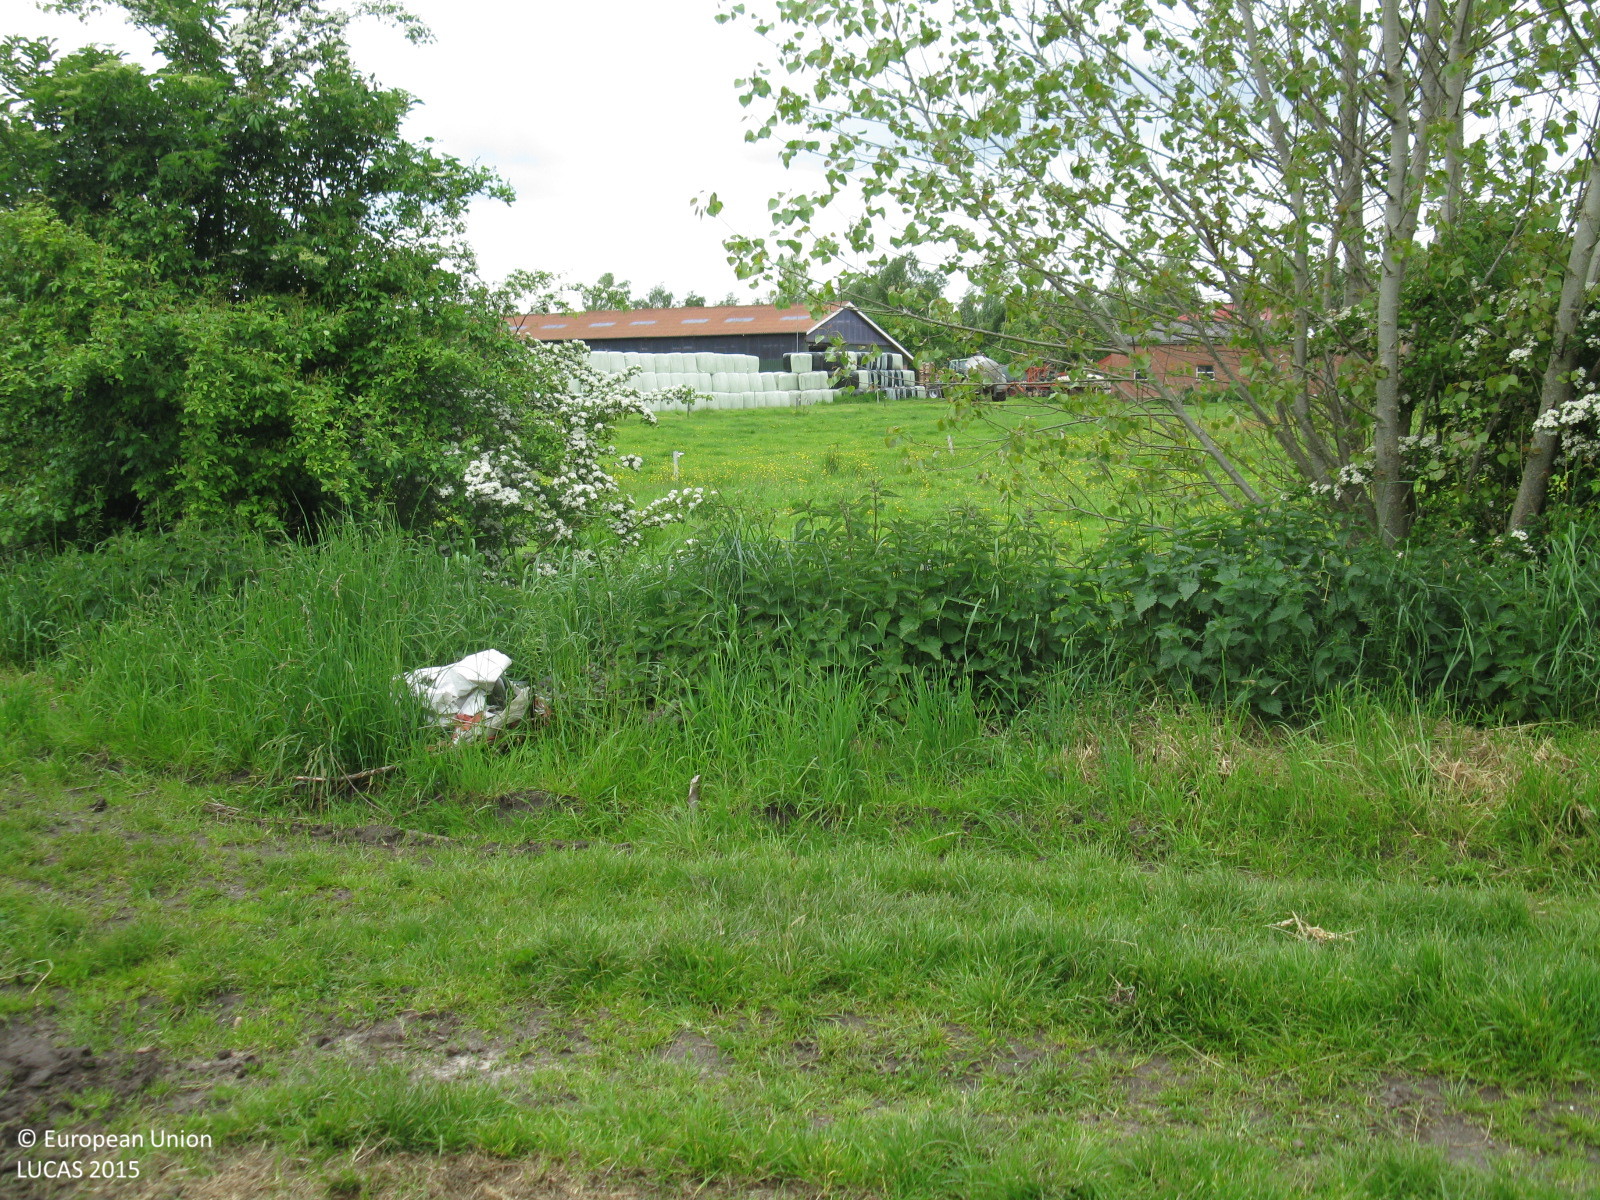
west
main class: Grassland
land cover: Grassland without tree/shrub cover
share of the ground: > 75 %
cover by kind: herbaceous plants 100 %
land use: Agriculture (excluding fallow land and kitchen gardens)
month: June
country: DE
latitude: 53.1566
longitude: 7.3236
